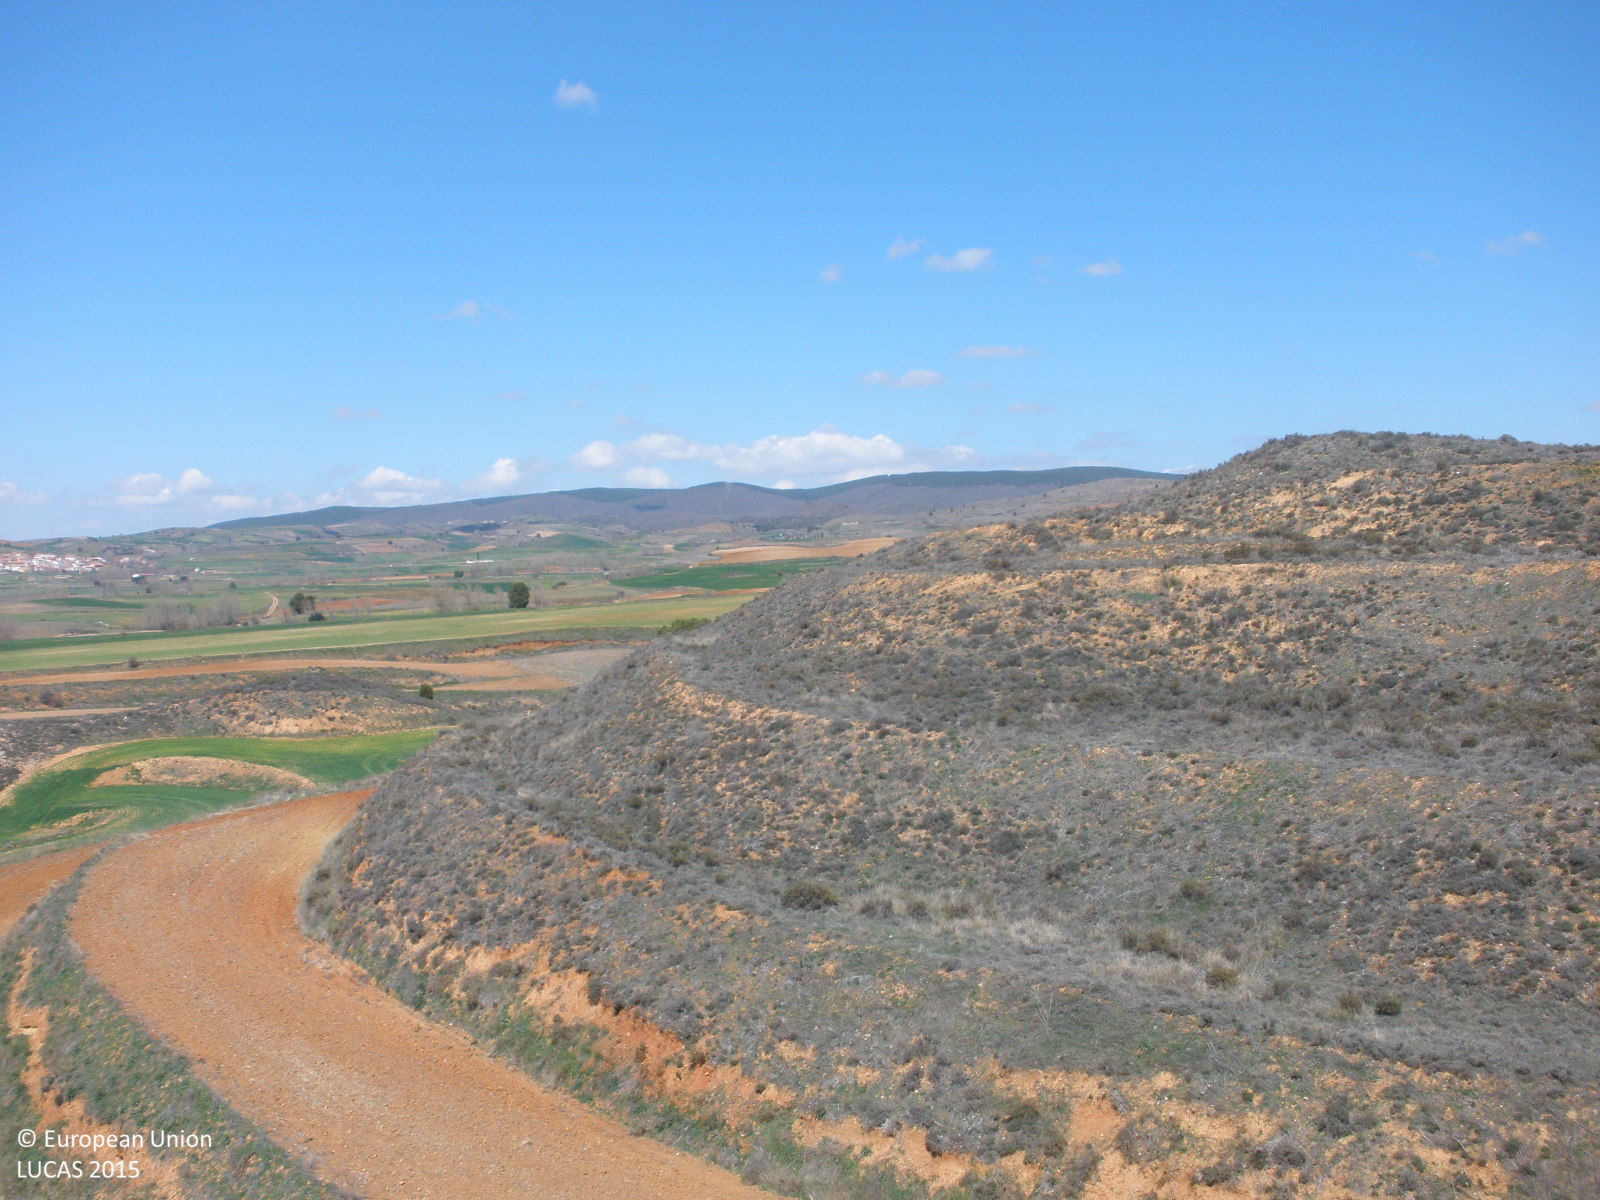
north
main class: Shrubland
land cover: Shrubland without tree cover
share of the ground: > 75 %
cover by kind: shrubs 70 %, herbaceous plants 30 %
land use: Semi-natural and natural areas not in use
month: April
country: ES
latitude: 40.9434
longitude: -1.1470
